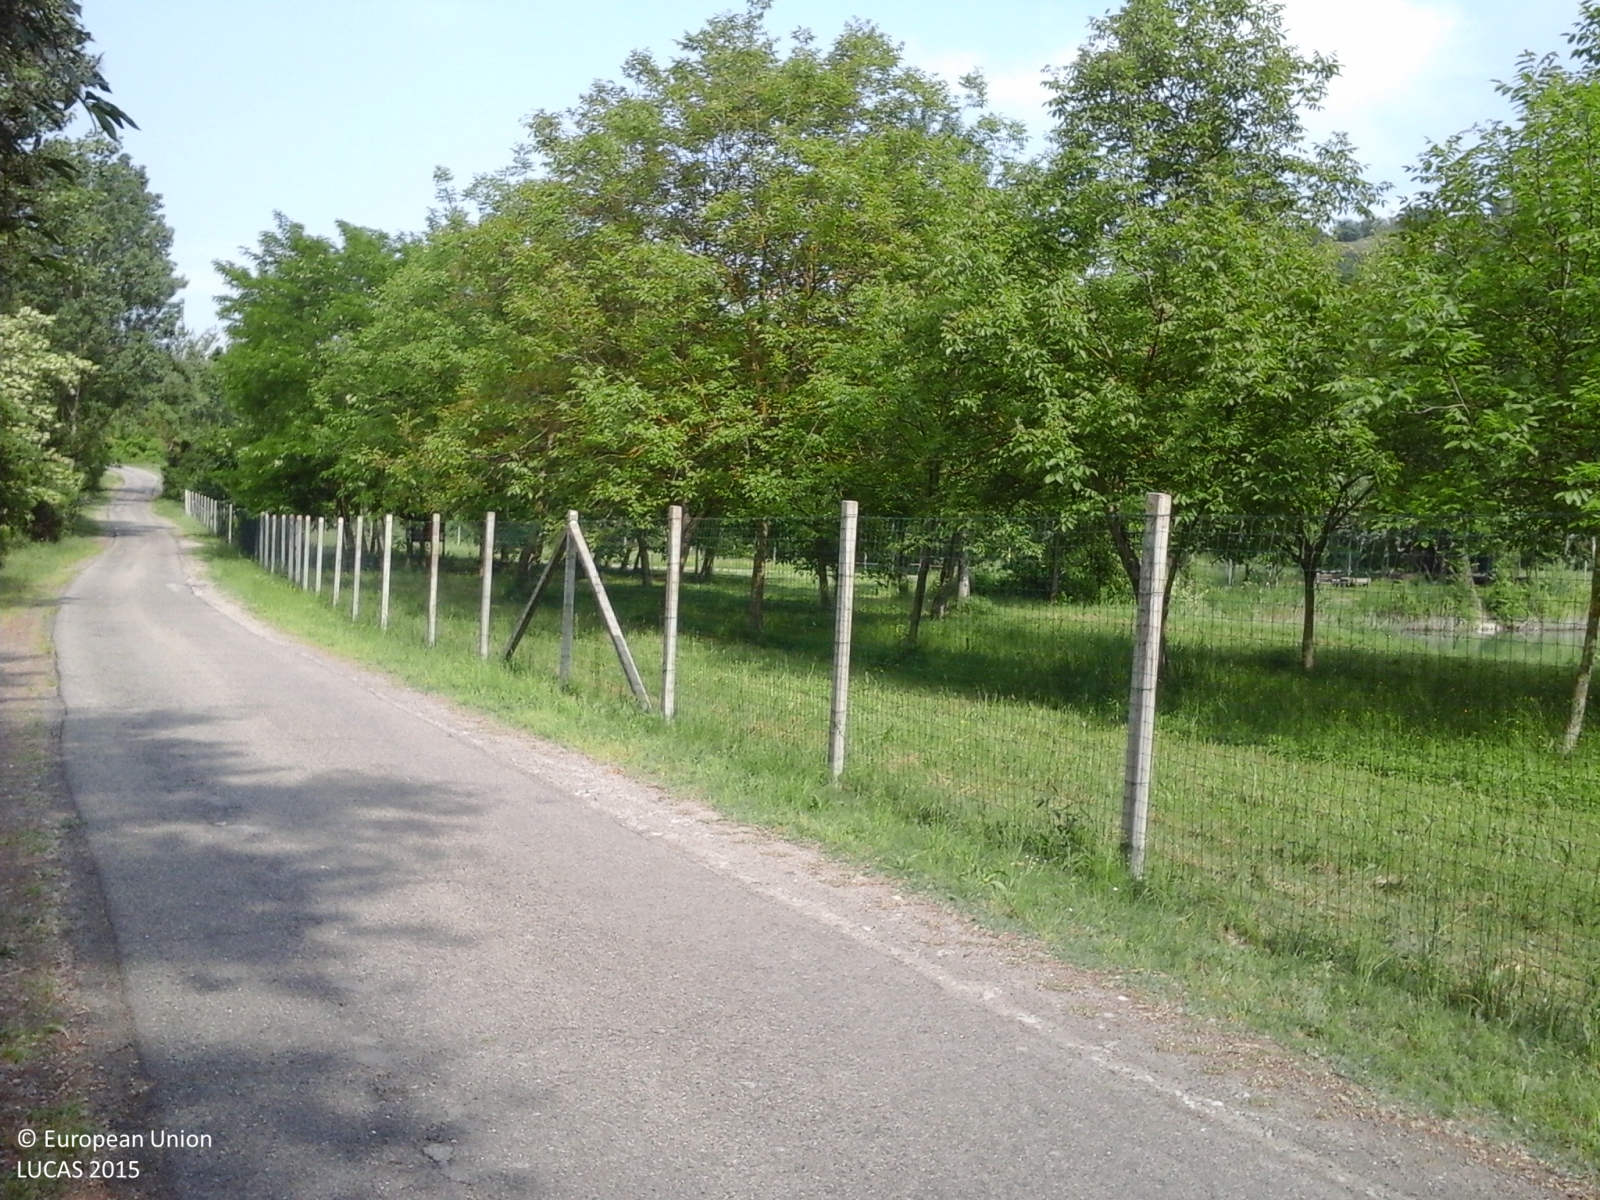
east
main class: Woodland
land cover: Broadleaved woodland
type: thermophilous deciduous forest
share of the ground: > 75 %
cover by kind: broadleaved forest trees 100 %
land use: Semi-natural and natural areas not in use
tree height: > 5 m
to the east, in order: Grass margins; Paved roads, cycling and walking lanes; Grass margins; Fences; Broadleaved woodland; Grassland without tree/shrub cover; Broadleaved woodland; Grassland without tree/shrub cover; Broadleaved woodland; Fences
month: May
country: IT
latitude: 44.5829
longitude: 10.6661
